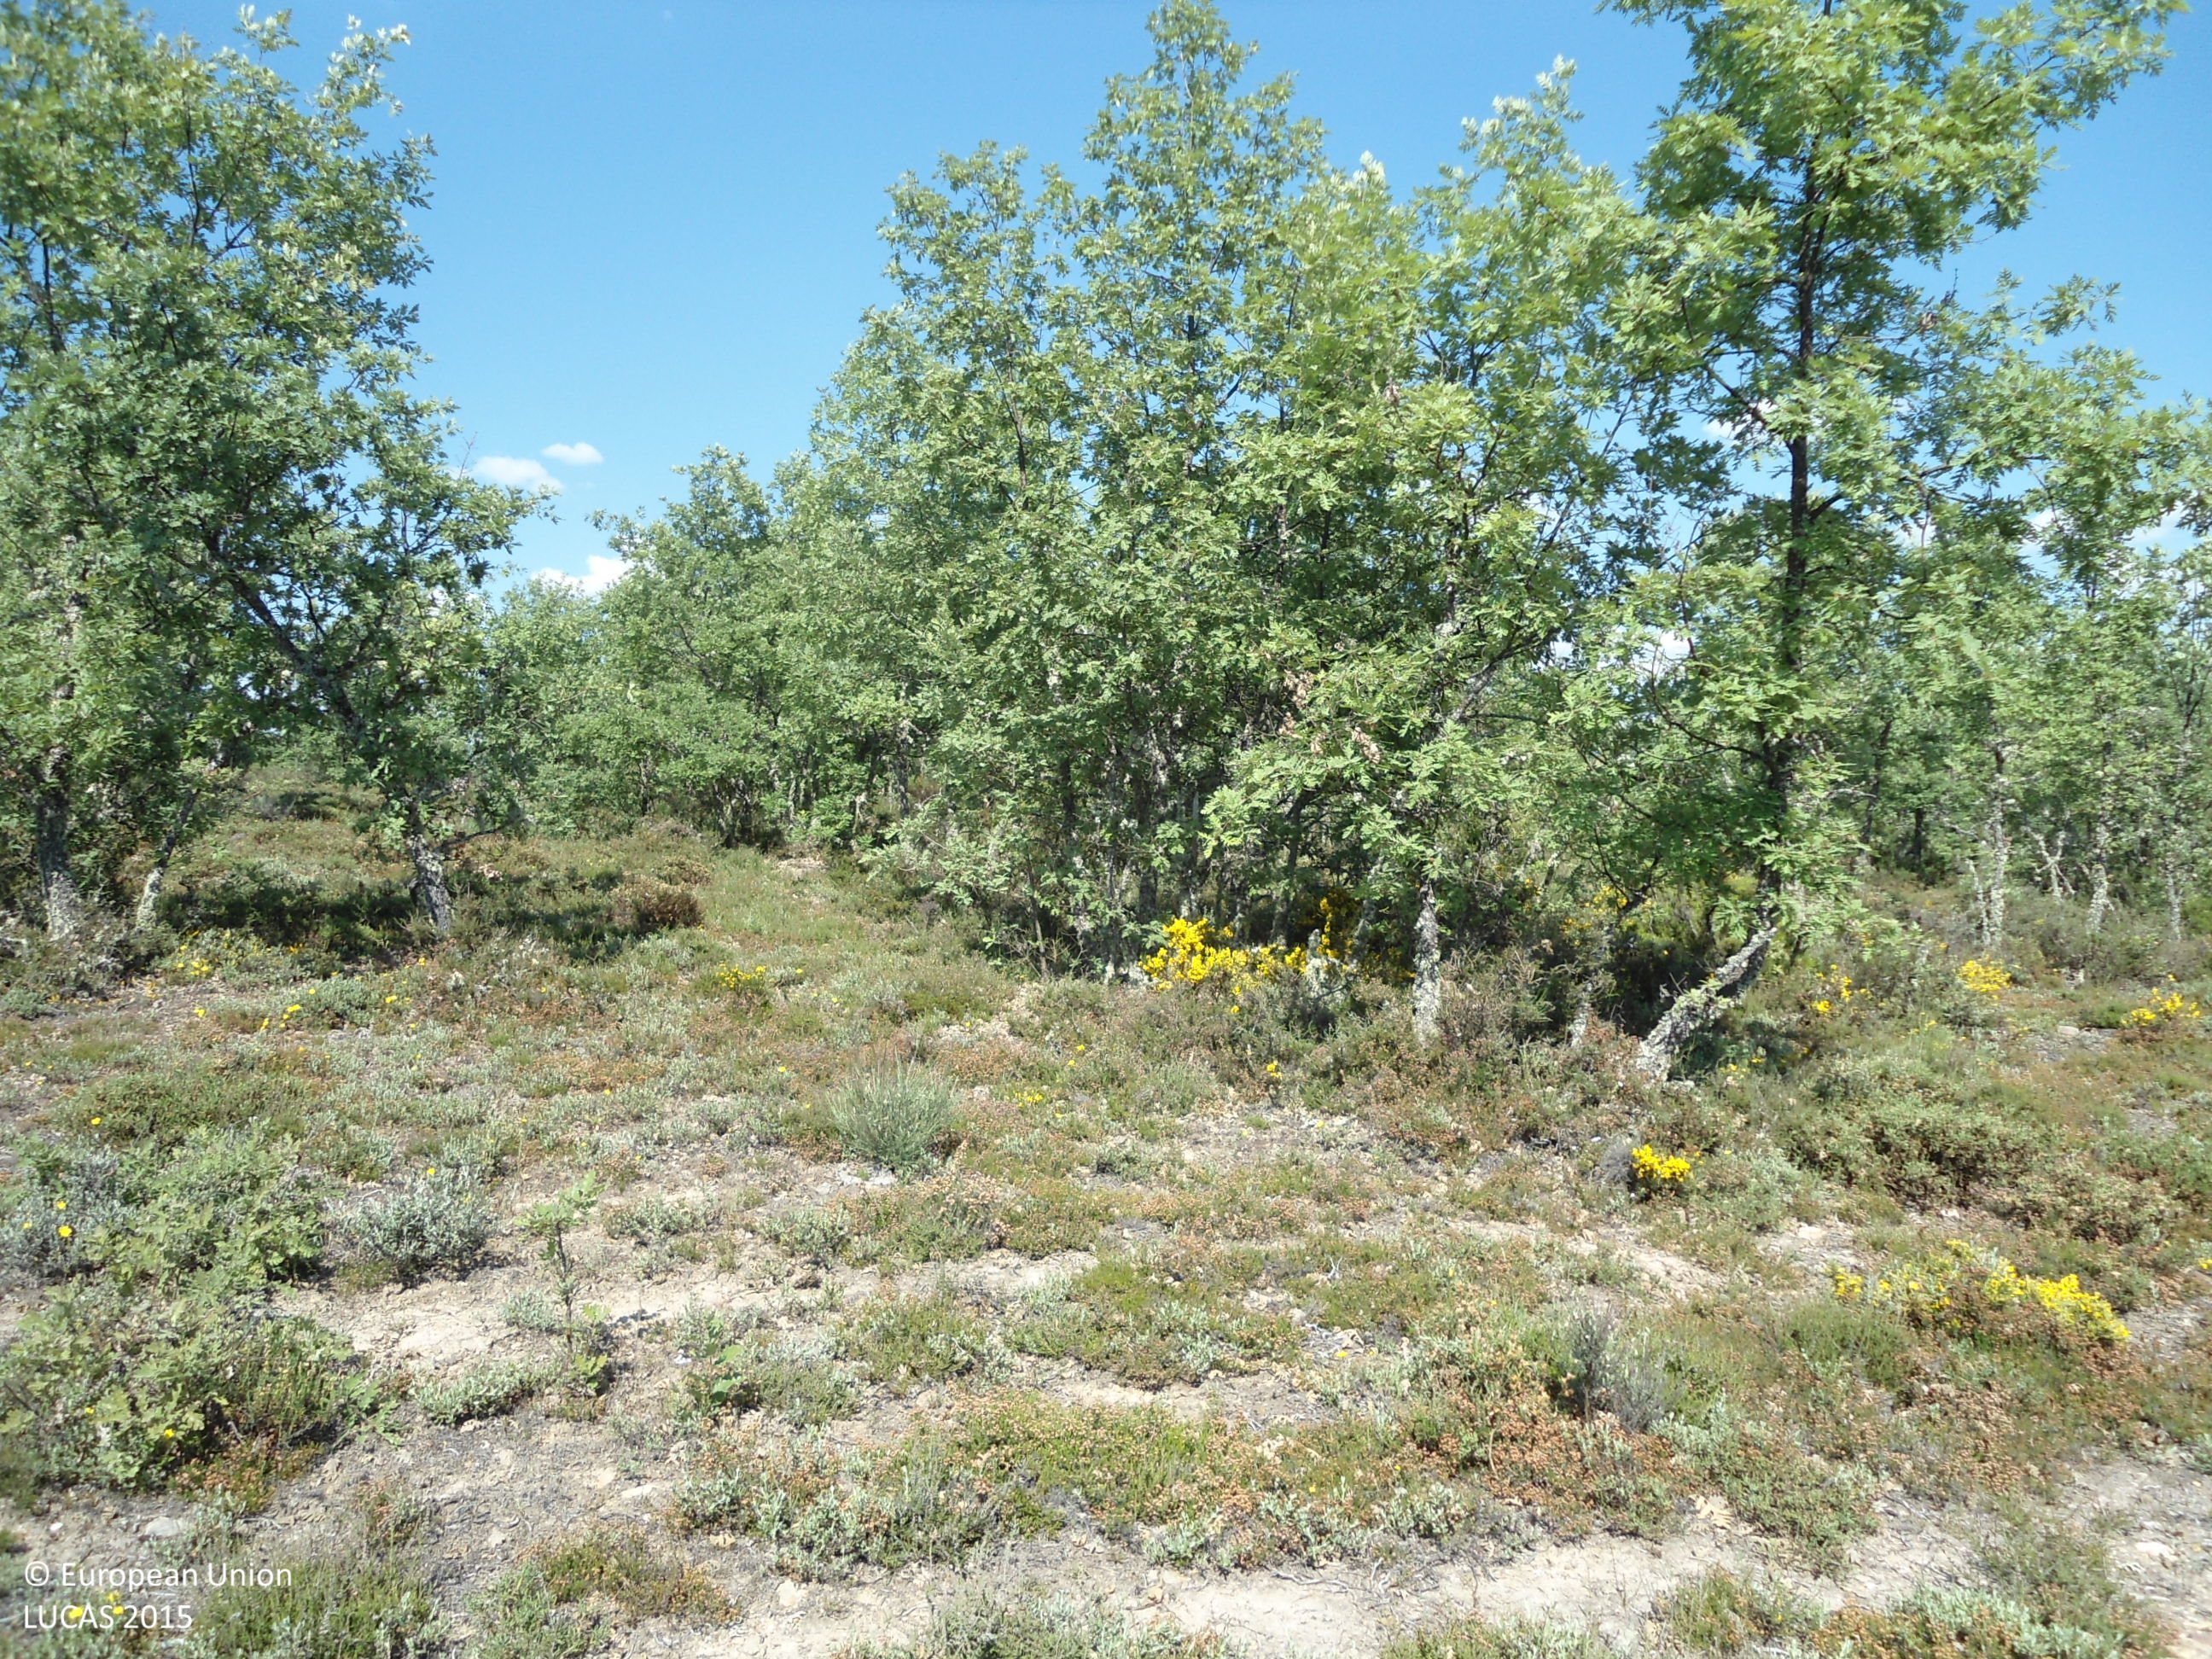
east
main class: Woodland
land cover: Broadleaved woodland
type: thermophilous deciduous forest
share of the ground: 50 - 75 %
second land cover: Shrubland without tree cover
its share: 50 - 75 %
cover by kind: broadleaved forest trees 50 %, shrubs 50 %
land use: Forestry
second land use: Agriculture (excluding fallow land and kitchen gardens)
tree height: > 5 m
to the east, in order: Broadleaved woodland; Shrubland without tree cover; Fences; Broadleaved woodland; Shrubland with sparse tree cover; Paved roads, cycling and walking lanes; Shrubland with sparse tree cover; Broadleaved woodland; Fences; Broadleaved woodland
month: June
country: ES
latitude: 42.1059
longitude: -6.3485
